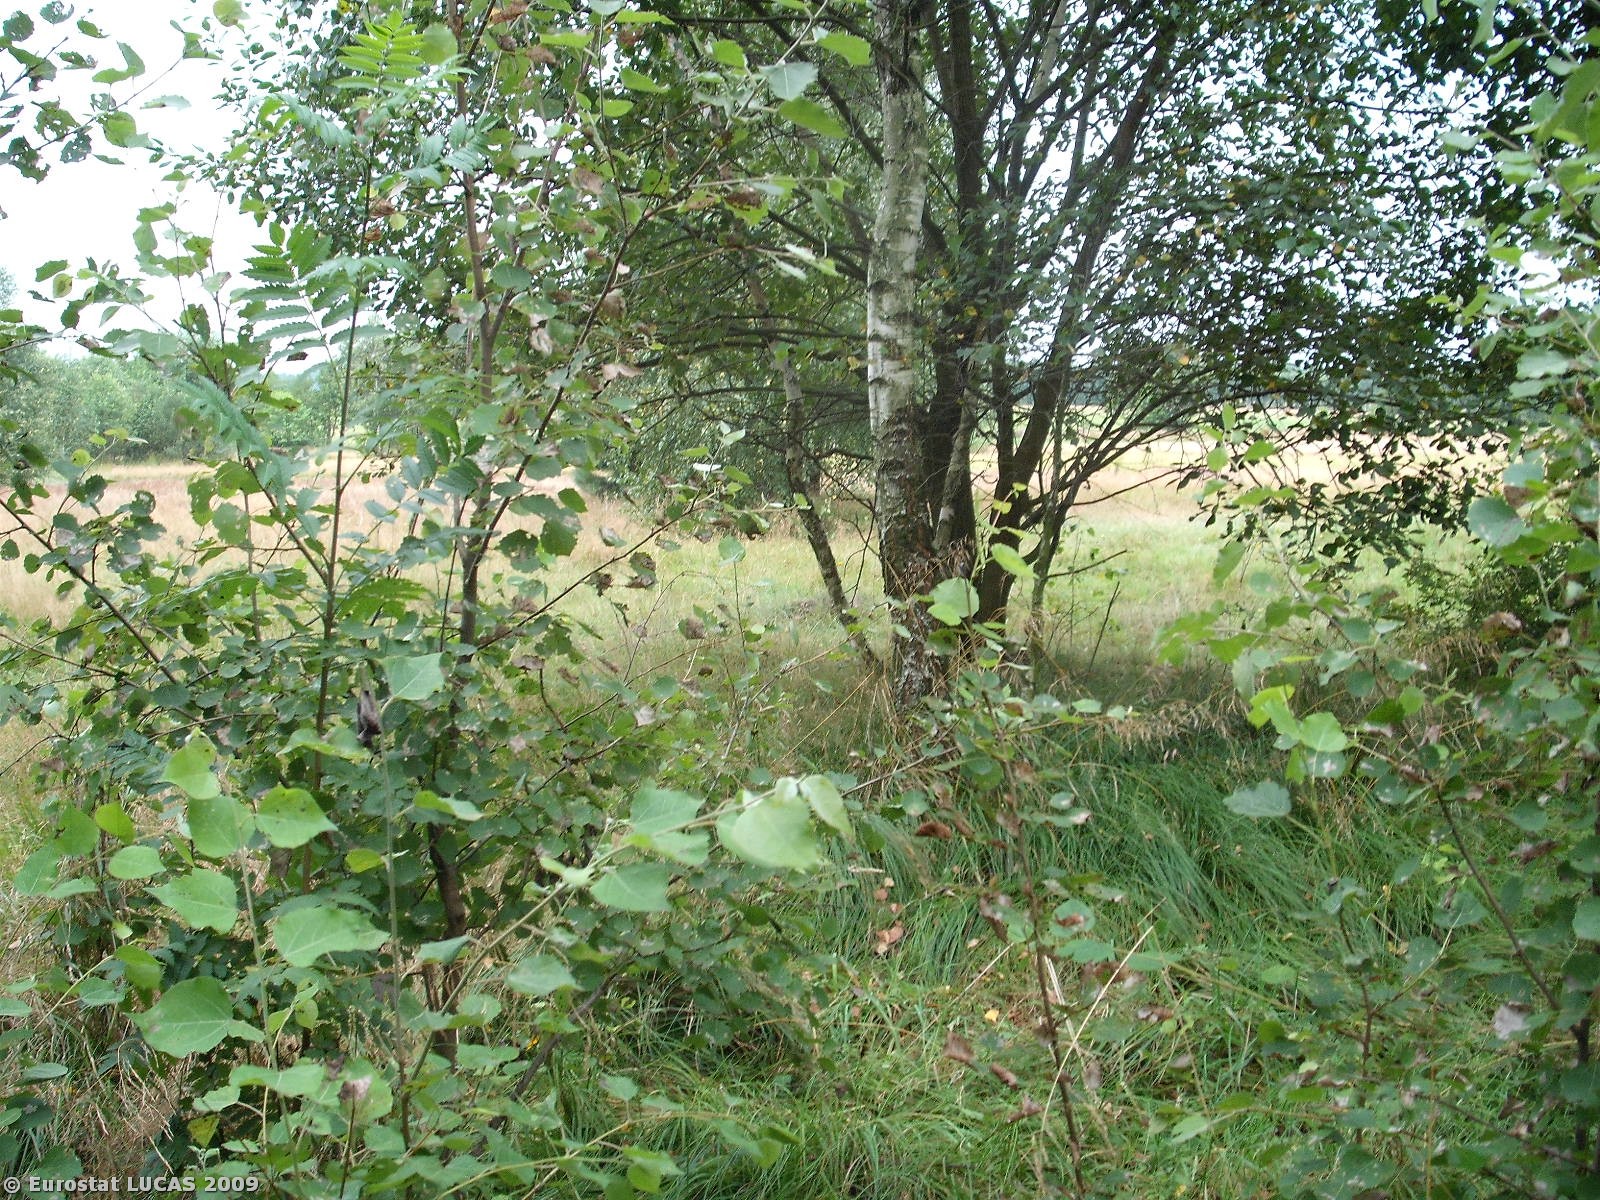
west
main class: Woodland
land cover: Broadleaved woodland
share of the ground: > 75 %
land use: Unused
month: August
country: PL
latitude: 52.3749
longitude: 21.7321
